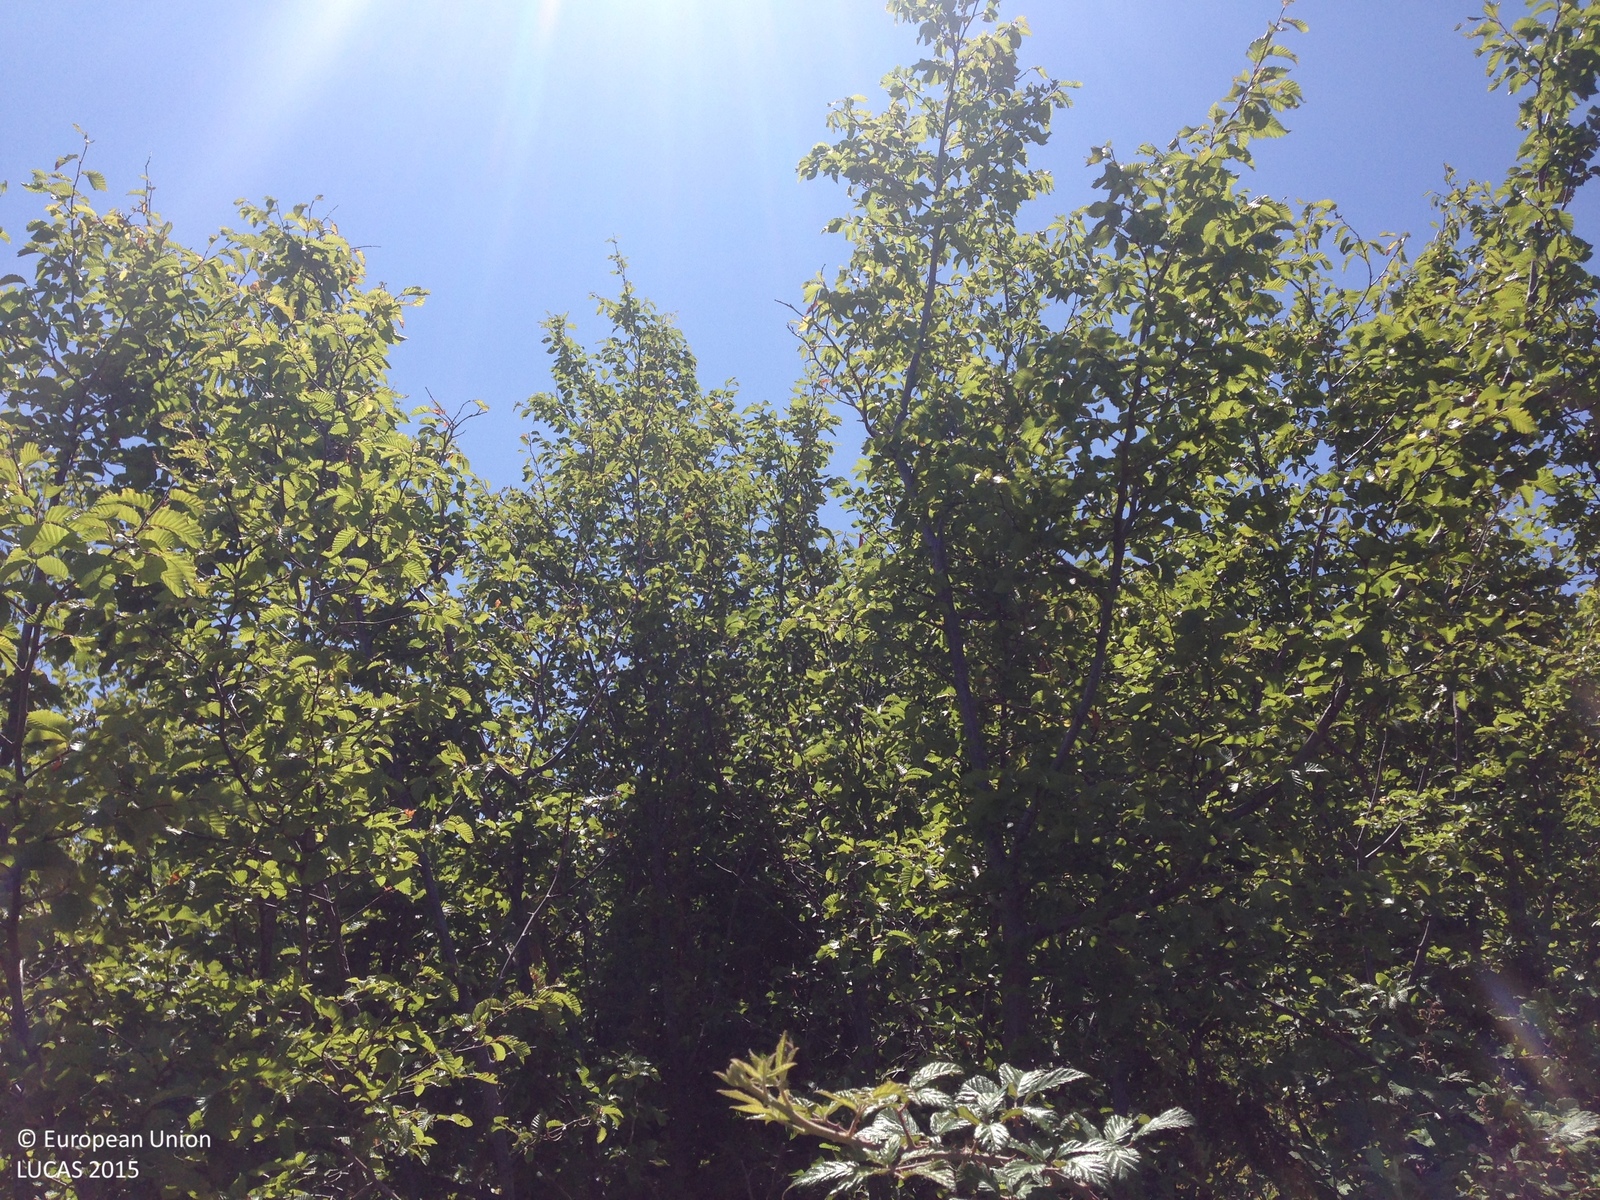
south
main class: Woodland
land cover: Broadleaved woodland
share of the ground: > 75 %
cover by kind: broadleaved forest trees 50 %, herbaceous plants 15 %, consolidated bare surface 15 %, shrubs 10 %, unconsolidated bare surface 10 %
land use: Semi-natural and natural areas not in use
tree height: < 5 m
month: July
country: HR
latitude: 44.1380
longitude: 15.7298
